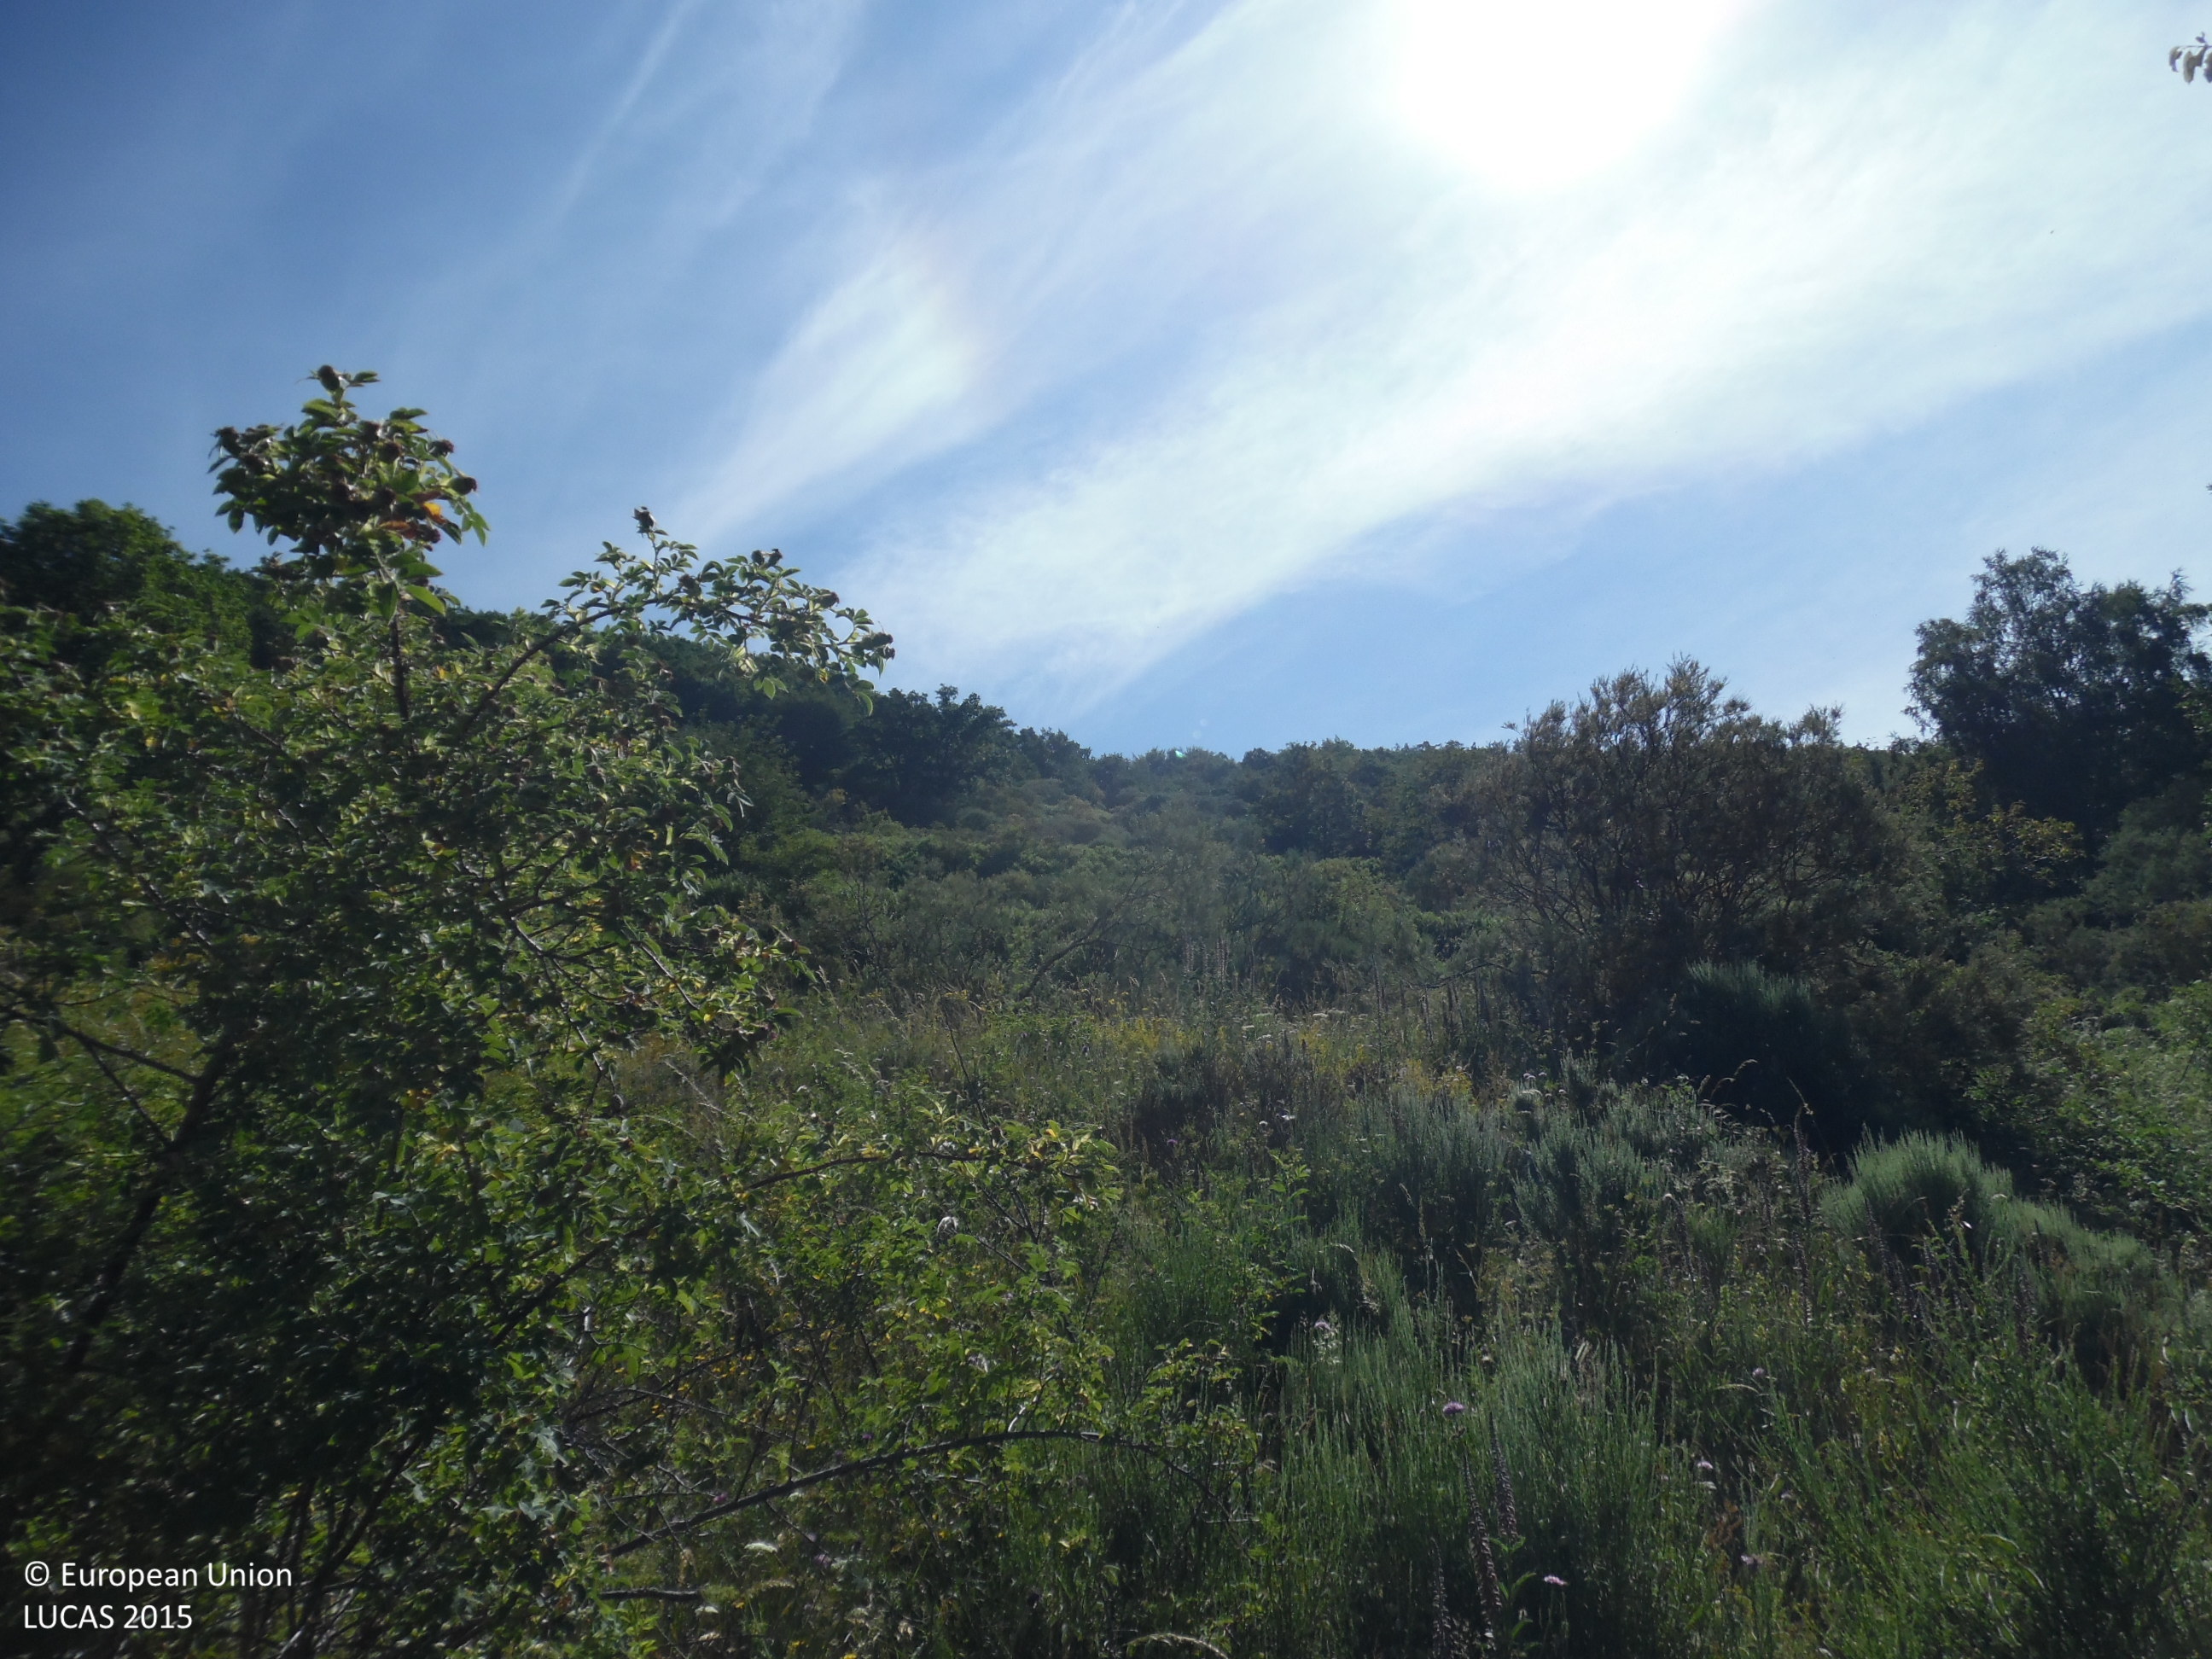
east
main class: Woodland
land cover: Broadleaved woodland
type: thermophilous deciduous forest
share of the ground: > 75 %
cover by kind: broadleaved forest trees 100 %
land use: Forestry
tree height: > 5 m
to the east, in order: Broadleaved woodland
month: July
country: ES
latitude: 42.9912
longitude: -5.5179
